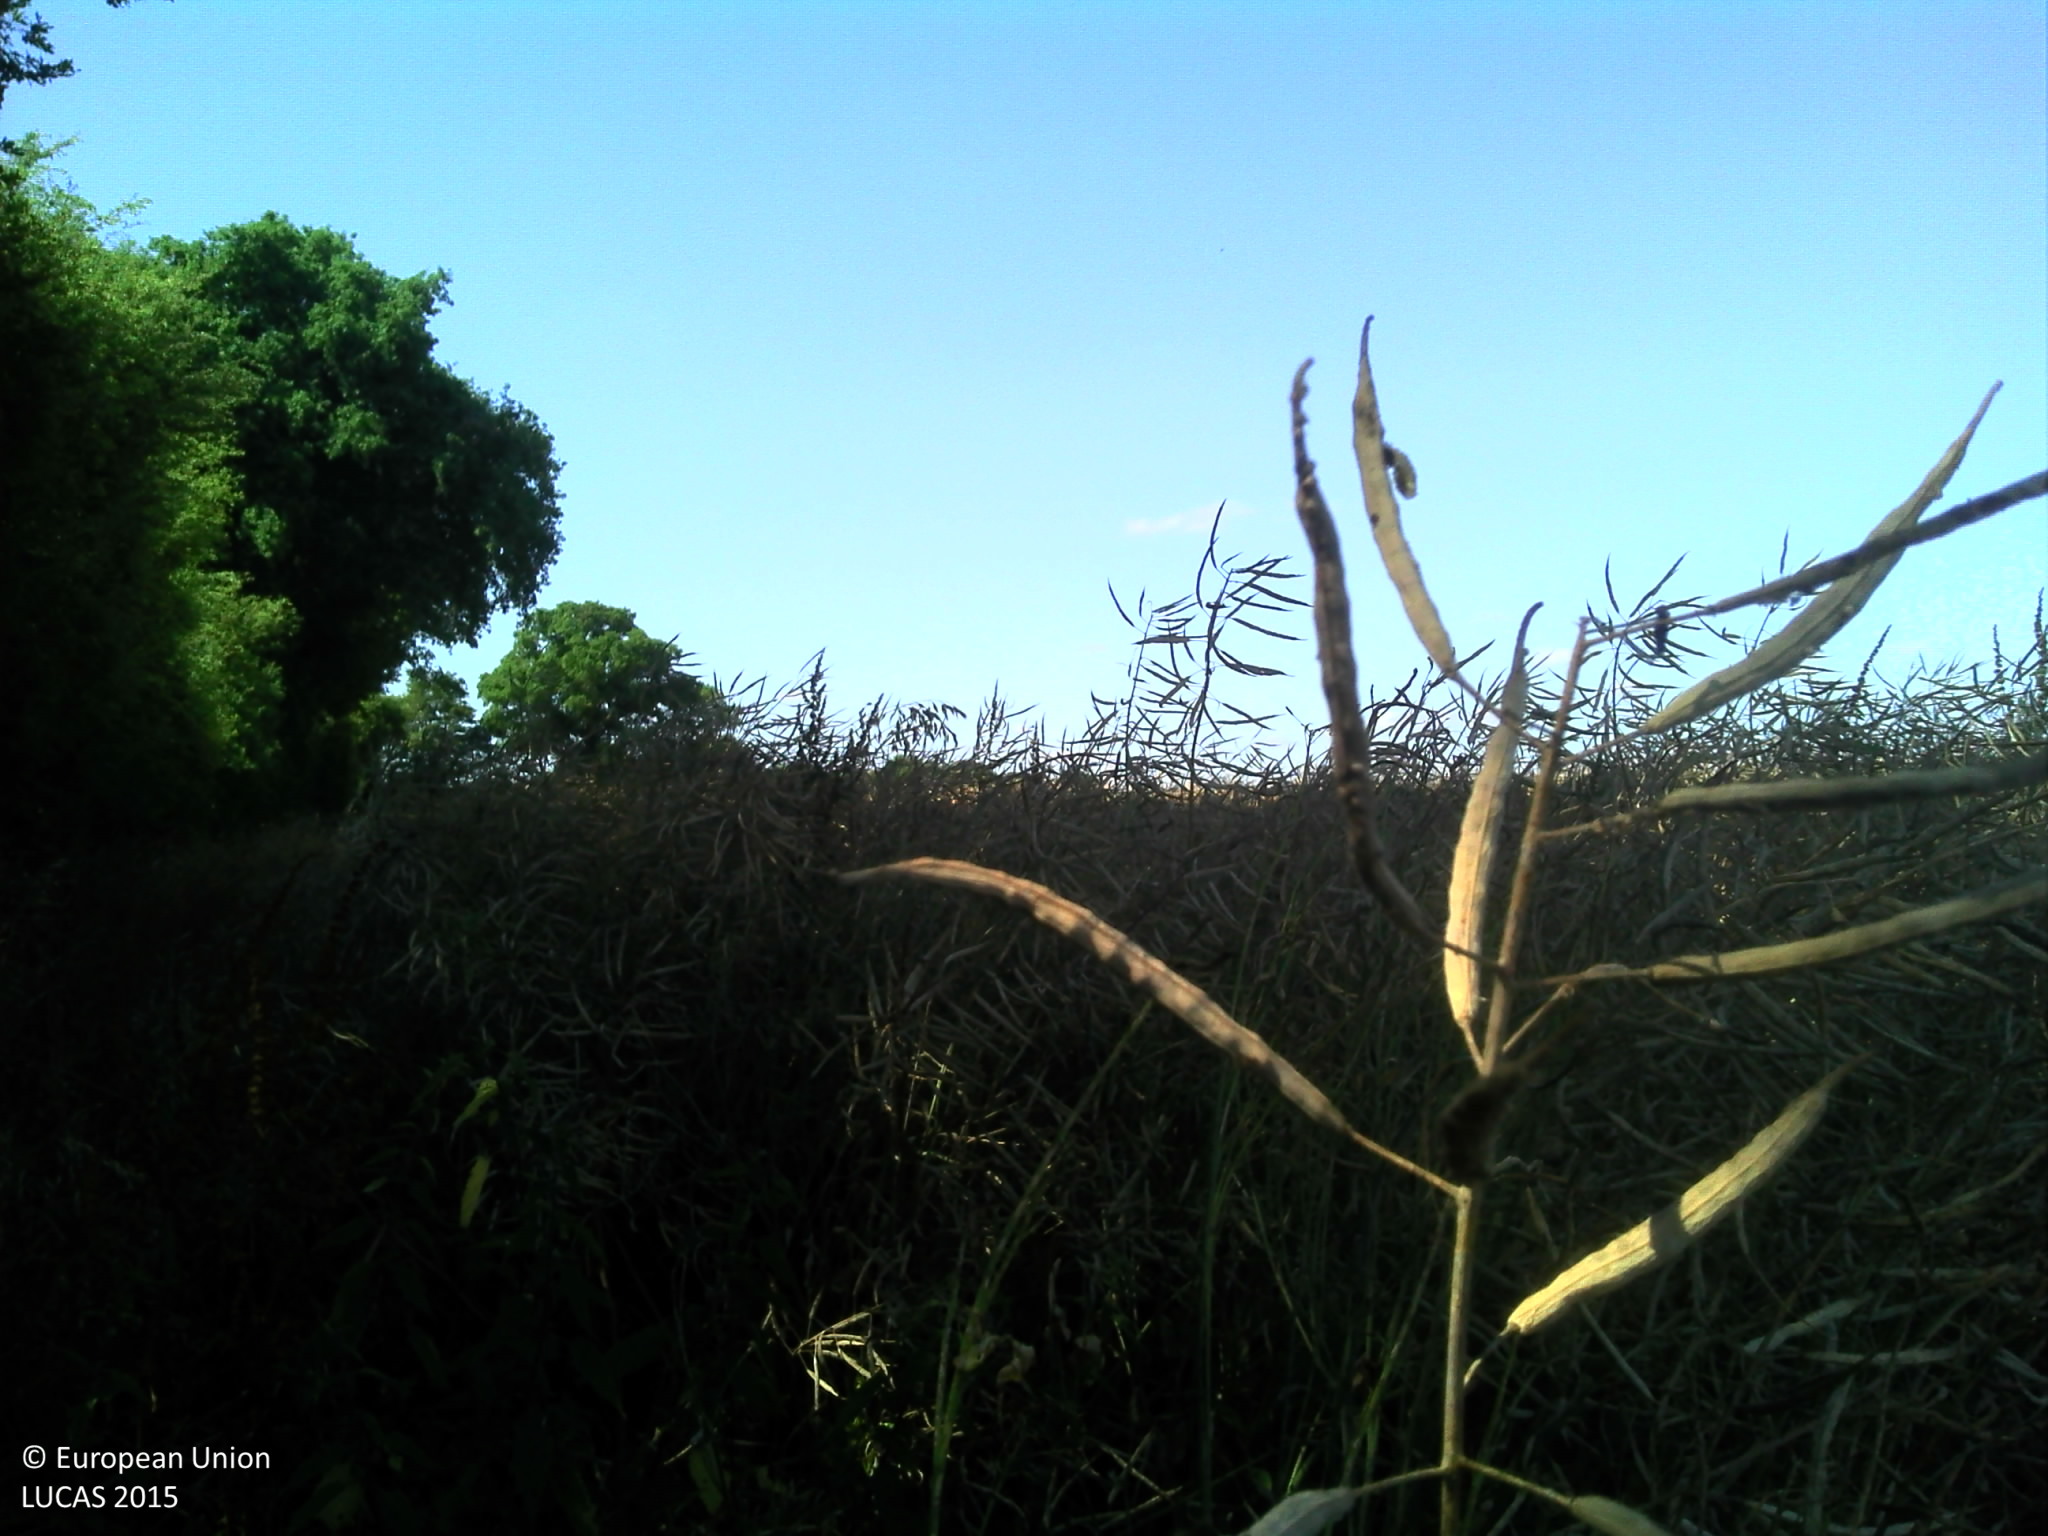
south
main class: Cropland
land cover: Rape and turnip rape
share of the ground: > 75 %
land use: Agriculture (excluding fallow land and kitchen gardens)
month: July
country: FR
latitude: 47.9294
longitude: 0.5953
